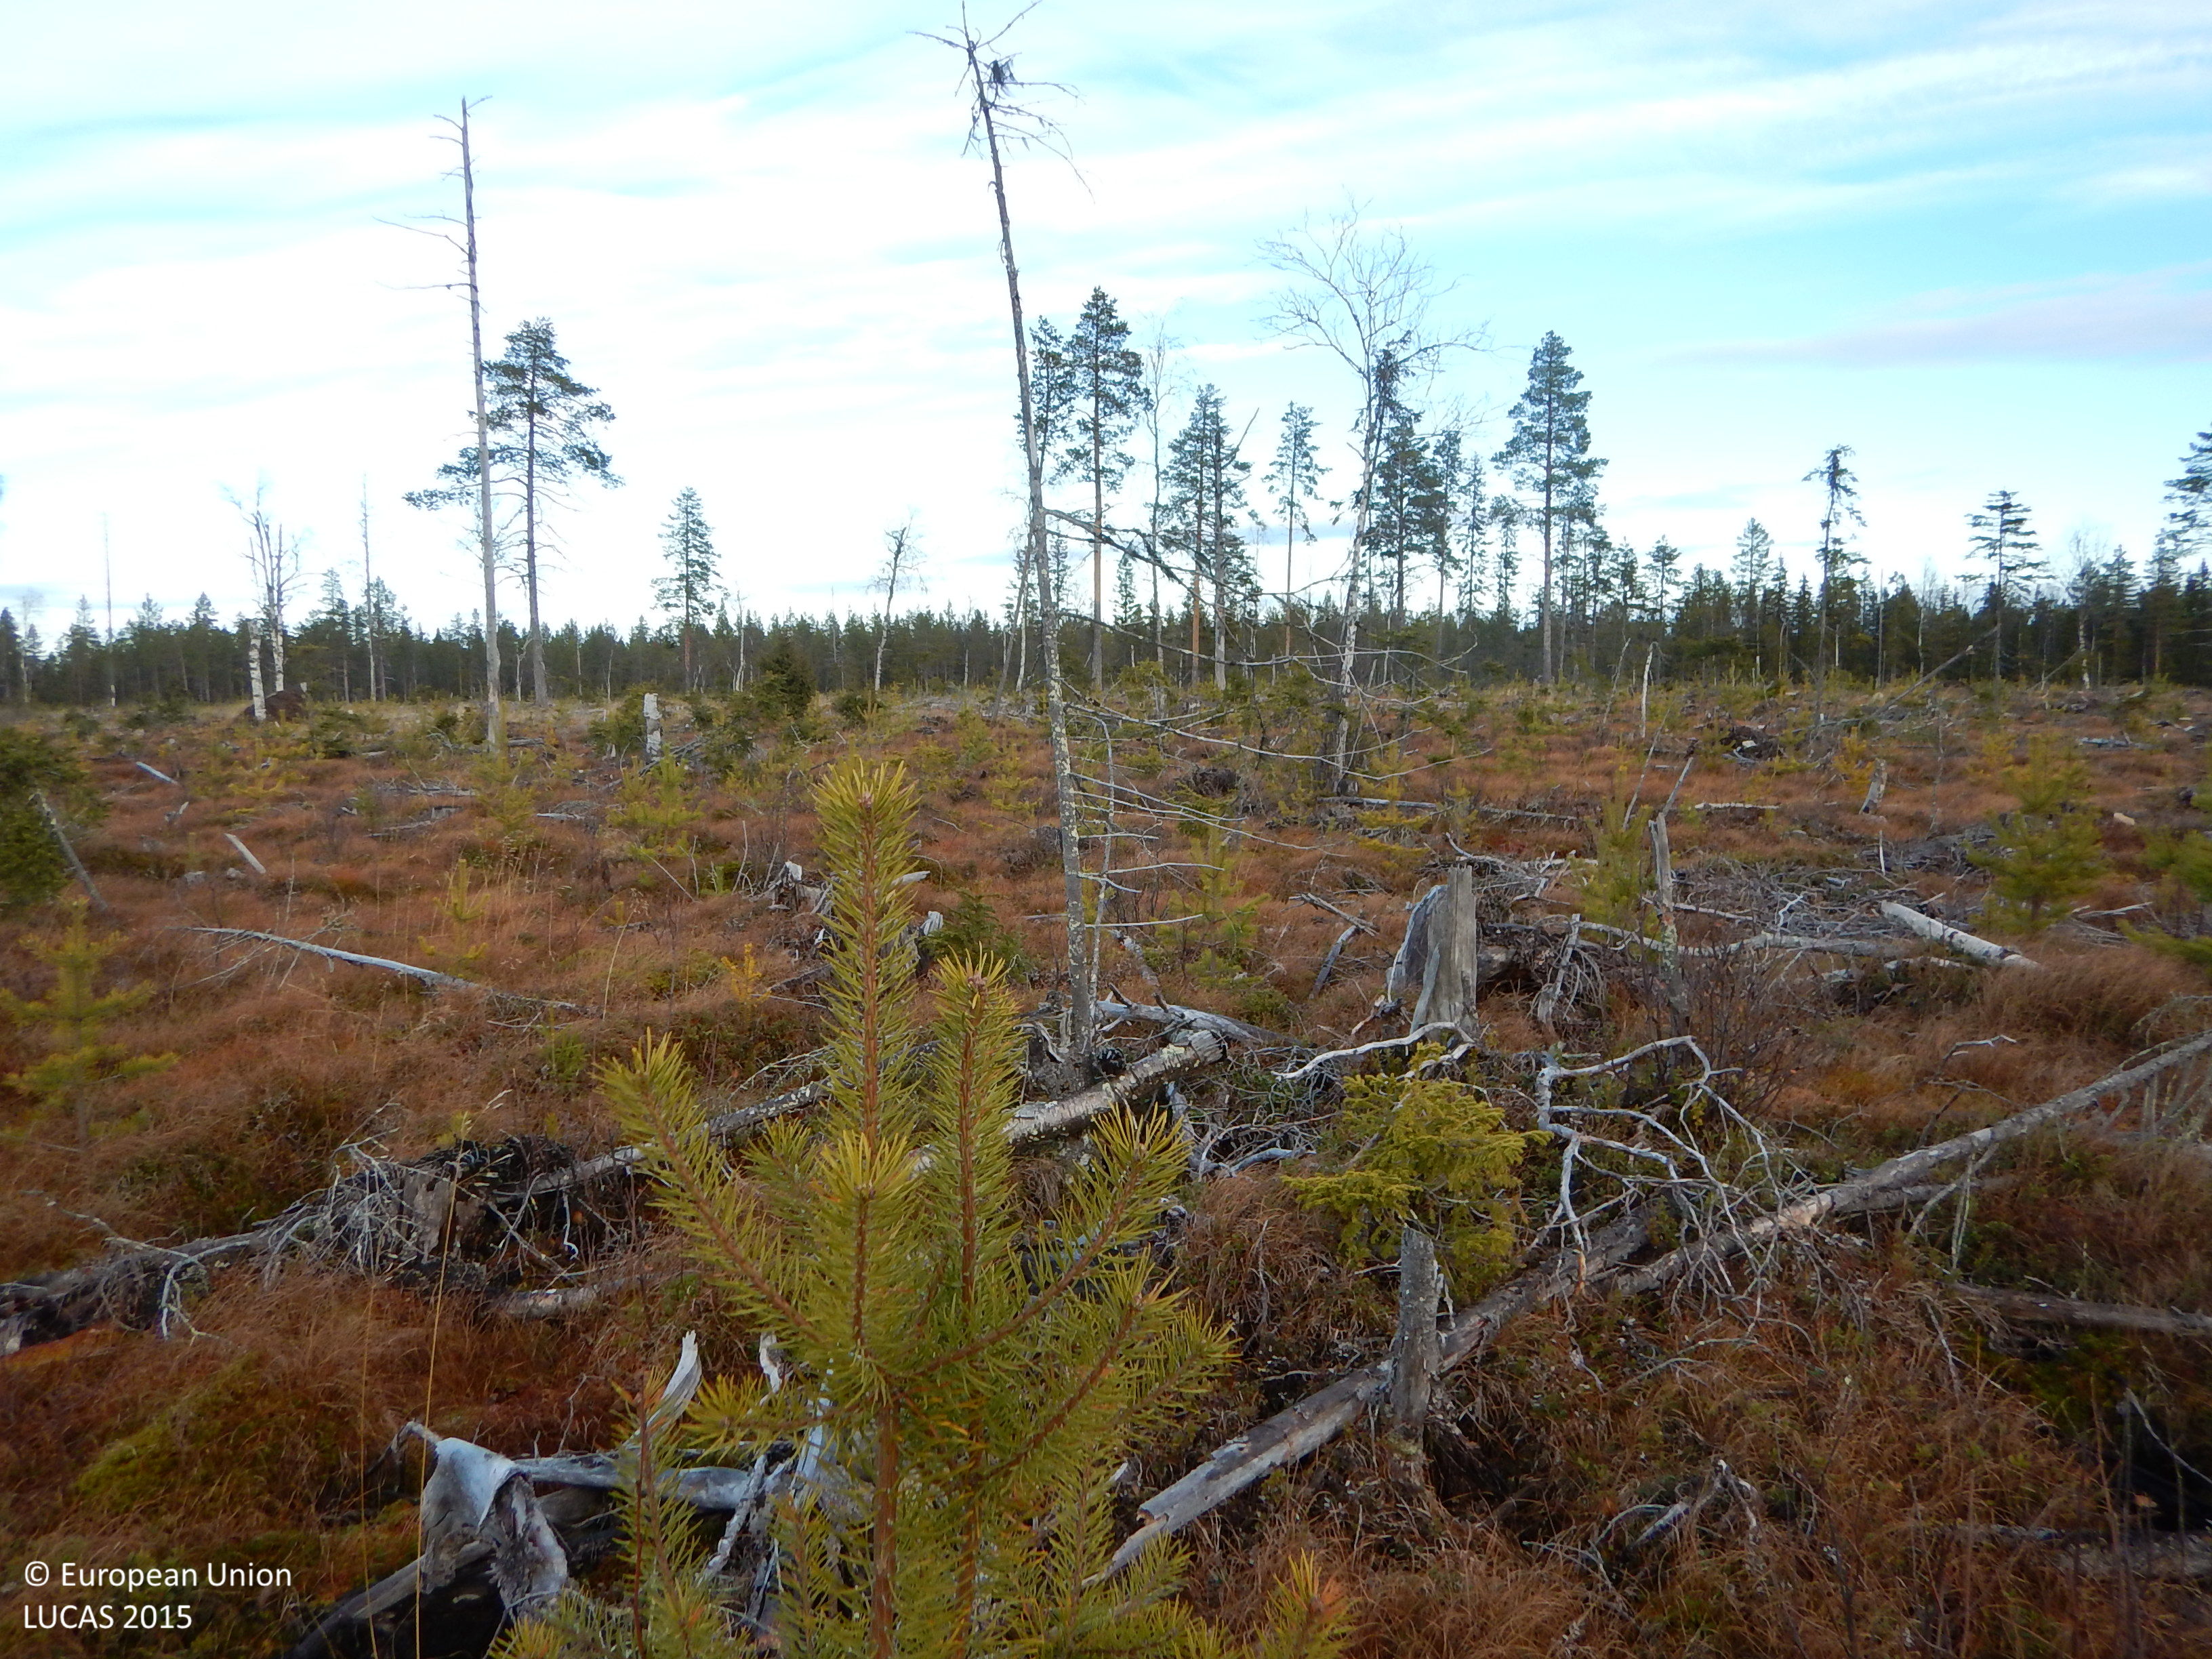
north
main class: Woodland
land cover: Pine dominated coniferous woodland
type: boreal forest
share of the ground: 25 - 50 %
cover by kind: lichens and mosses 30 %, shrubs 25 %, coniferous forest trees 20 %, herbaceous plants 20 %, broadleaved forest trees 5 %
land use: Forestry
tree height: < 5 m
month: November
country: SE
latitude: 65.3060
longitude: 20.5453
